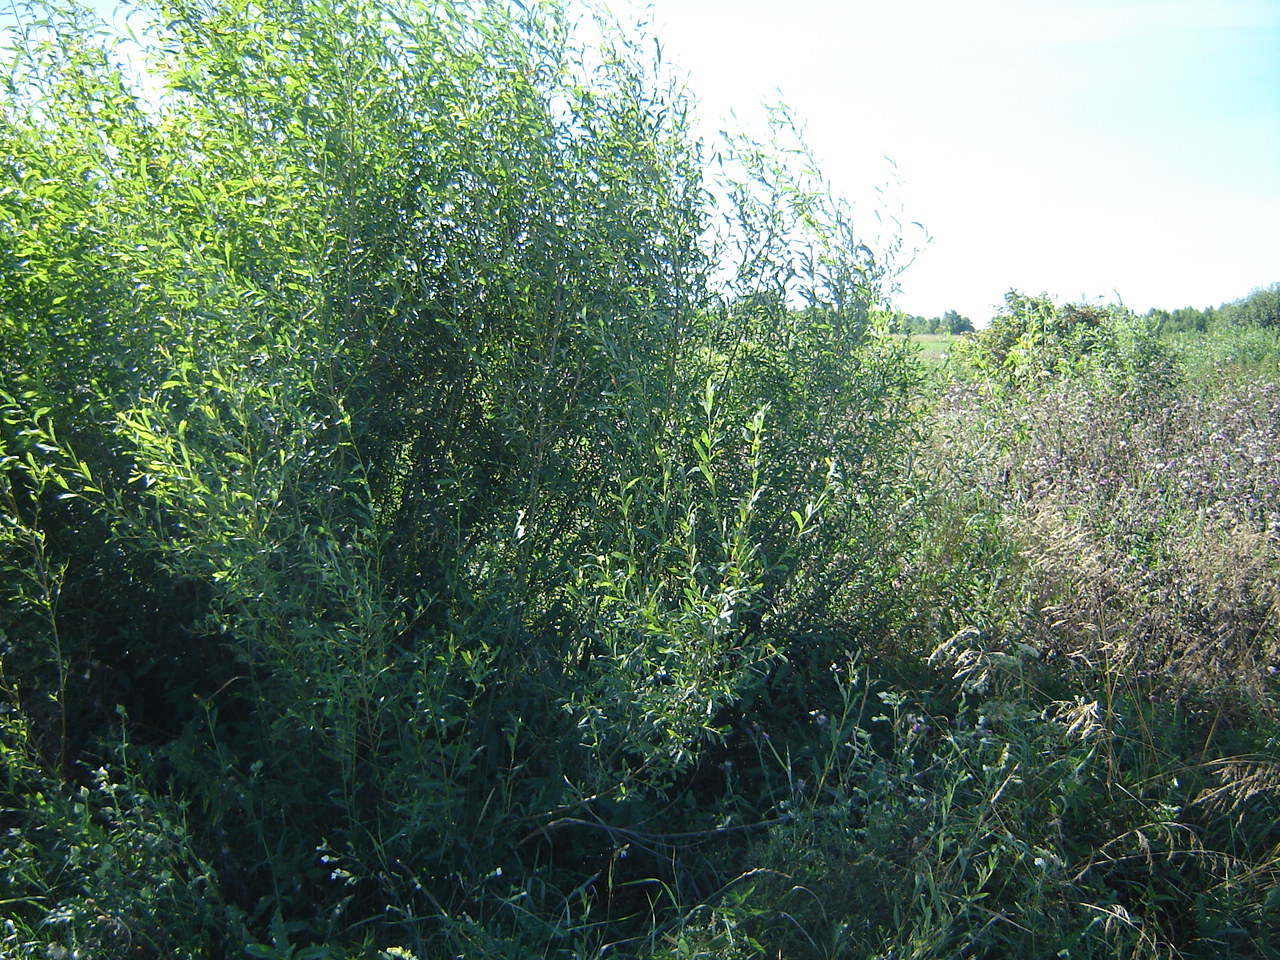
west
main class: Grassland
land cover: Grassland without tree/shrub cover
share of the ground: > 75 %
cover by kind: herbaceous plants 100 %
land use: Agriculture (excluding fallow land and kitchen gardens)
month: August
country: LT
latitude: 54.8826
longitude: 25.2556
